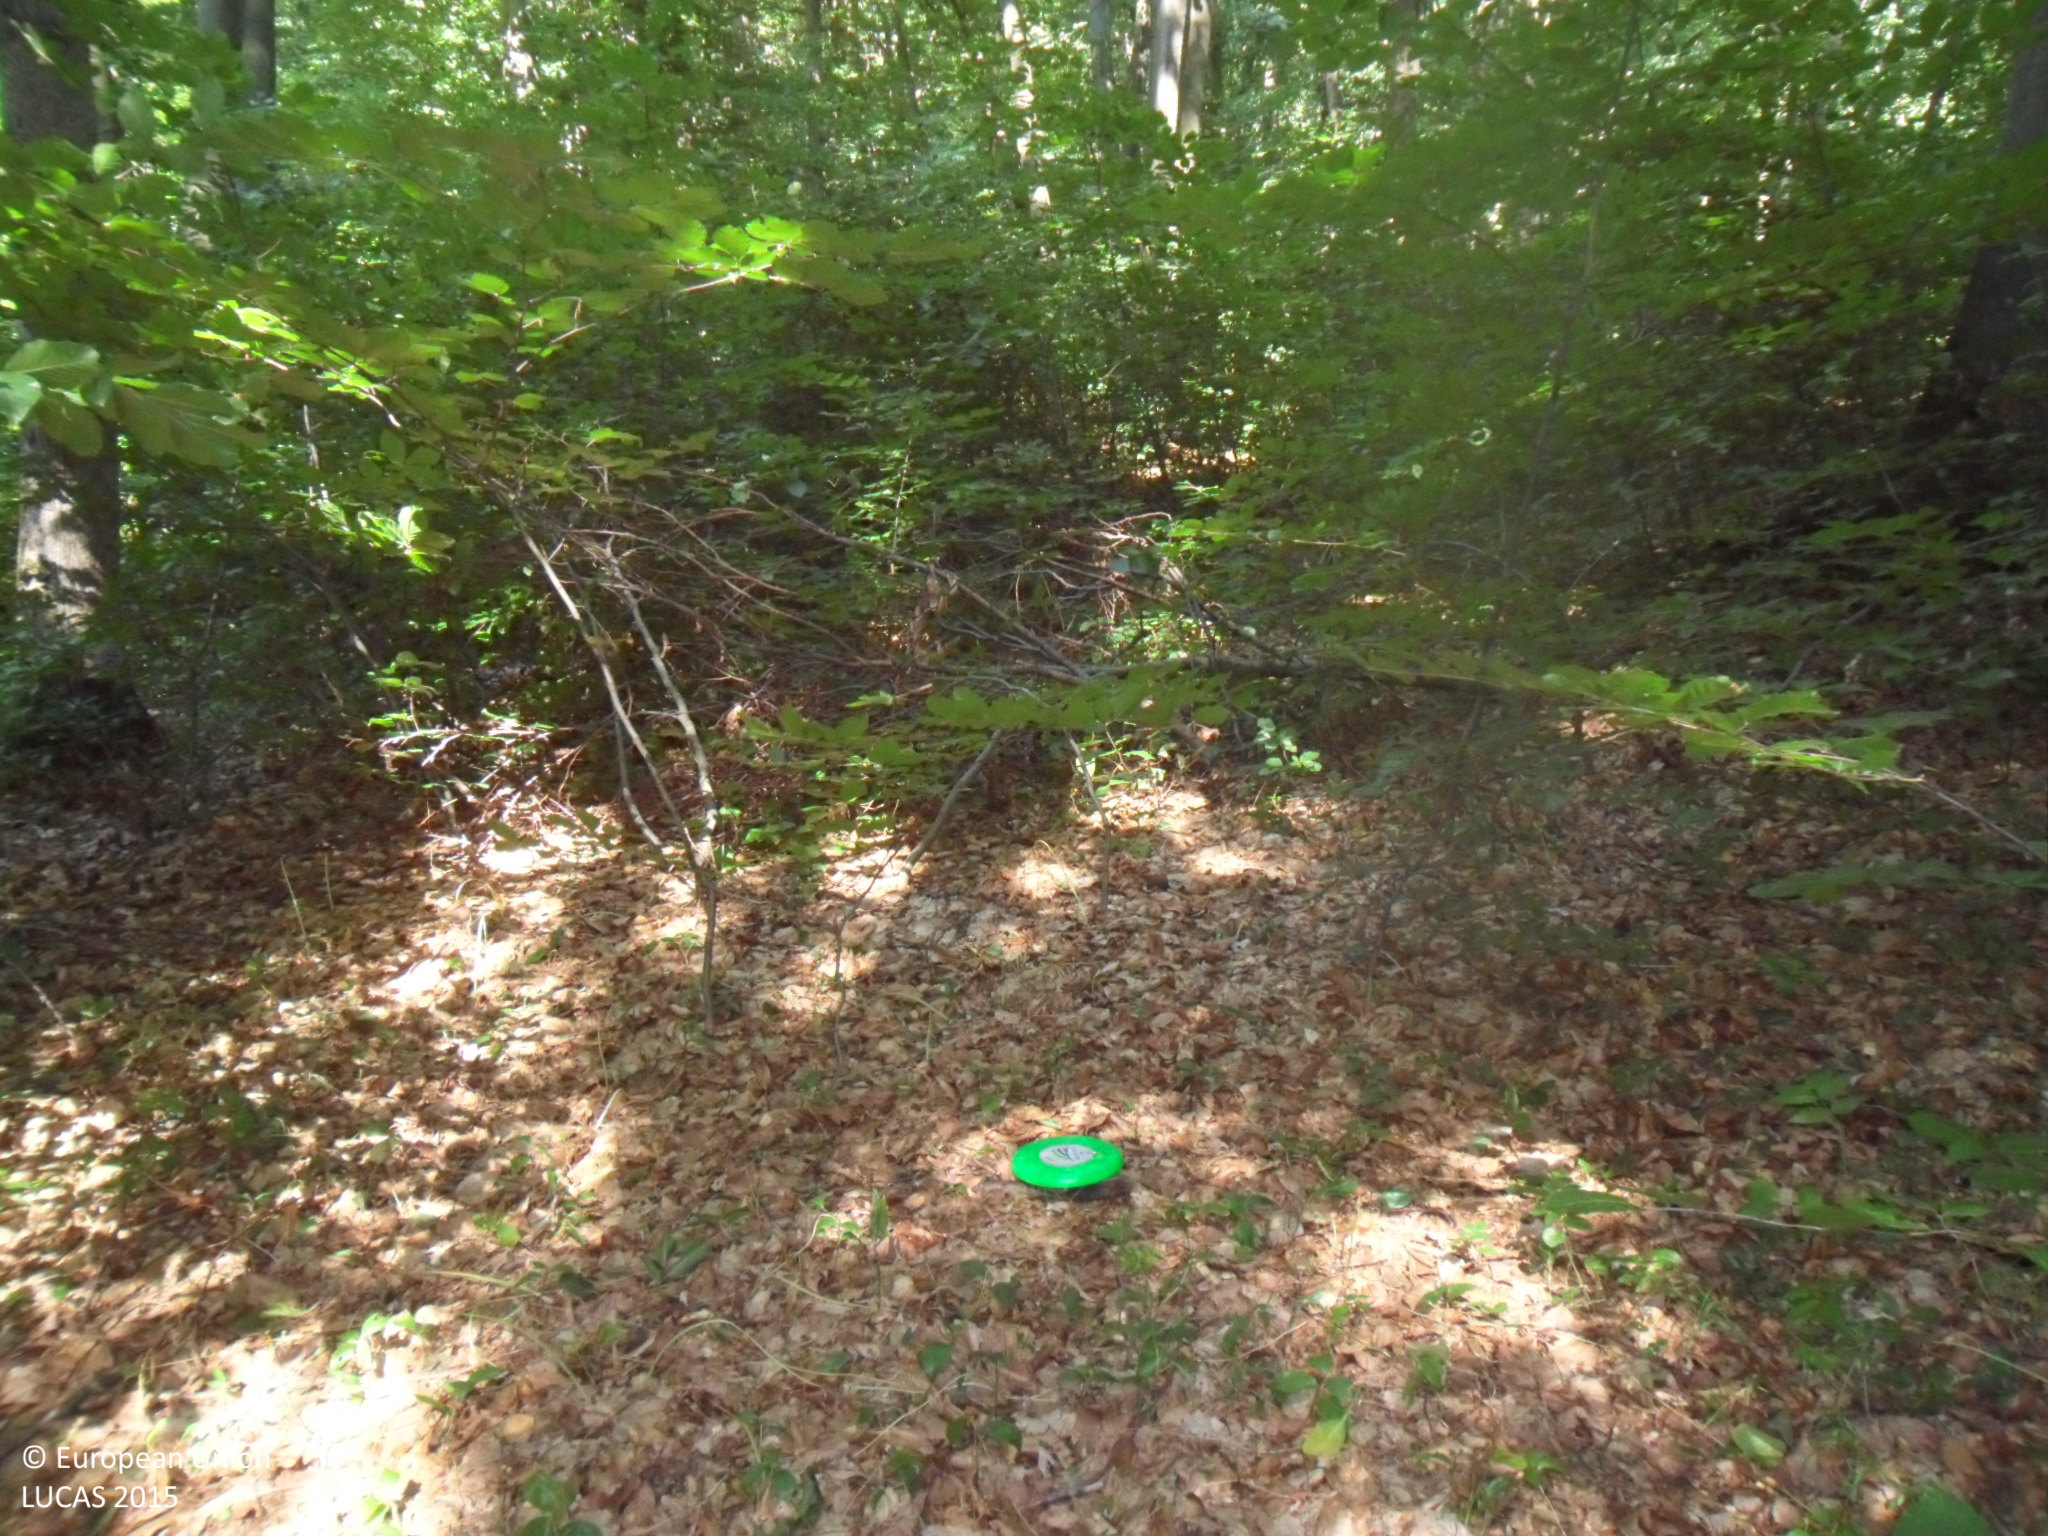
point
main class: Woodland
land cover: Broadleaved woodland
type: beech forest
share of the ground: > 75 %
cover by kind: broadleaved forest trees 95 %, shrubs 5 %
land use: Amenities, museums, leisure
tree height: > 5 m
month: June
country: BG
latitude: 43.2683
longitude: 26.8796
